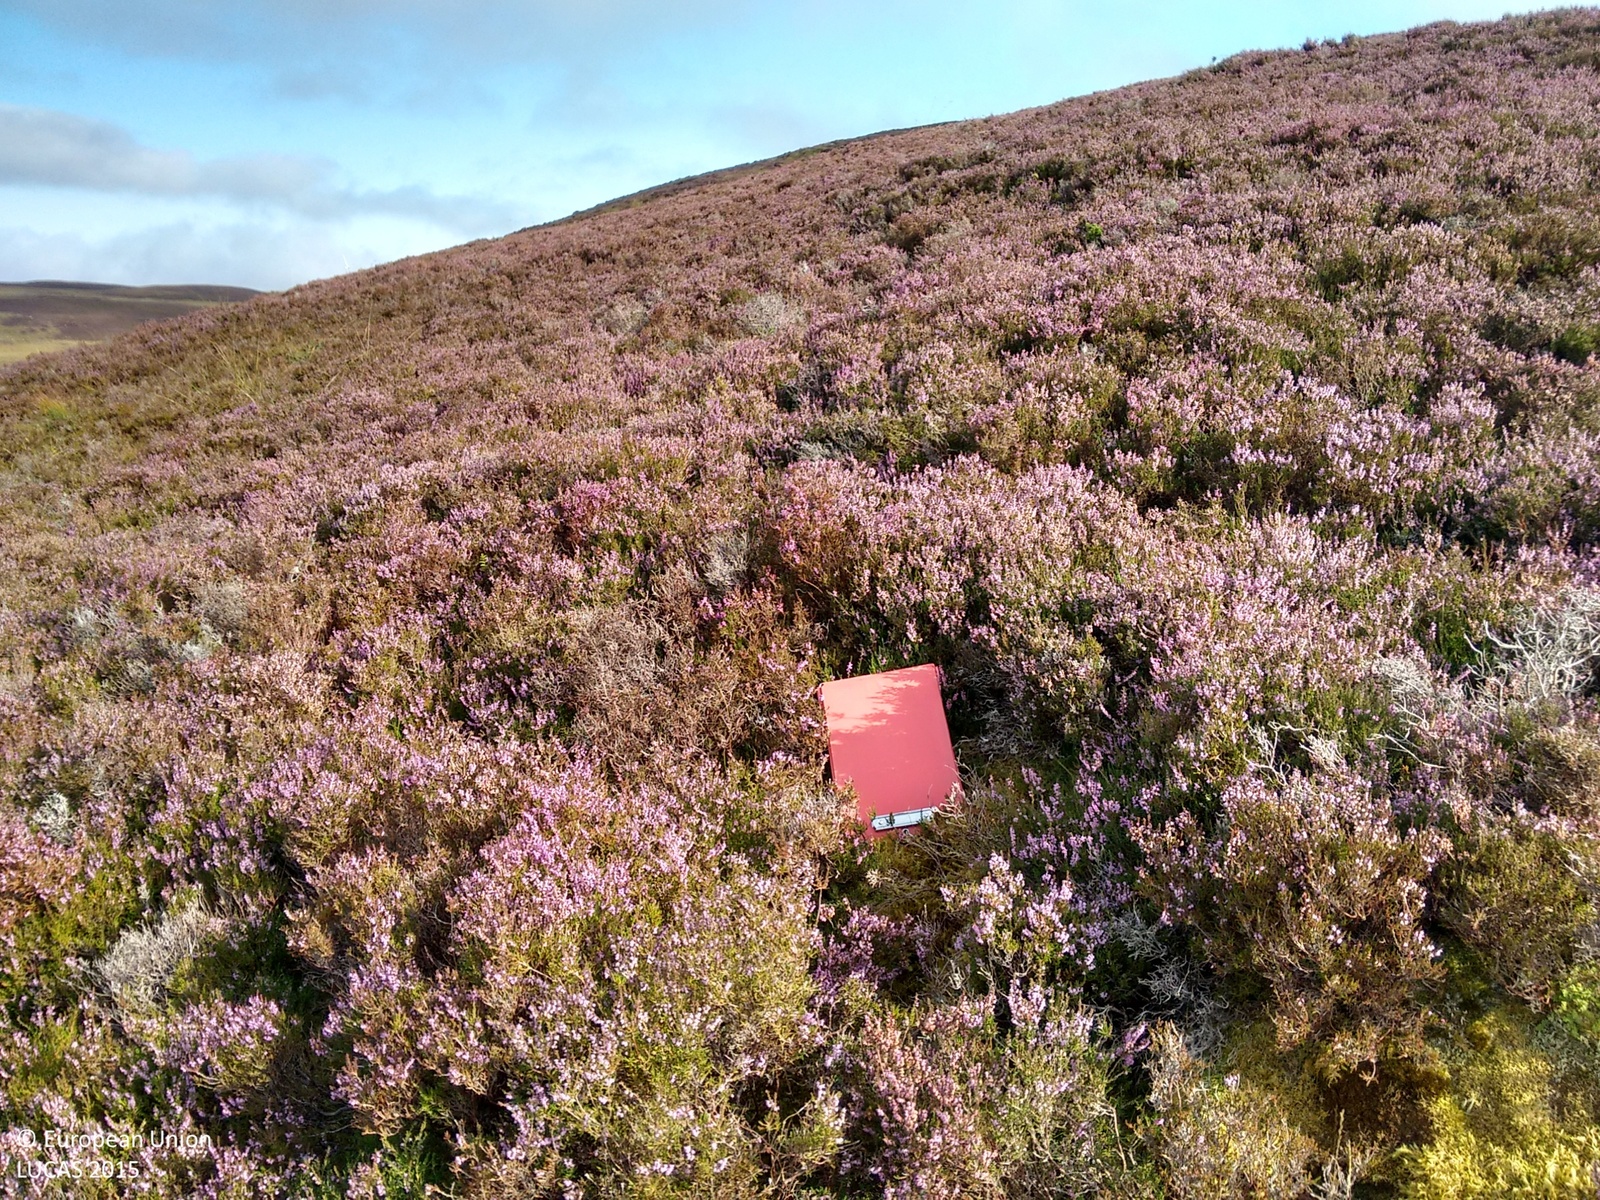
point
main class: Shrubland
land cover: Shrubland without tree cover
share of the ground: > 75 %
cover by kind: shrubs 100 %
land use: Agriculture (excluding fallow land and kitchen gardens)
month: September
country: GB
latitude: 58.0363
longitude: -4.1200
